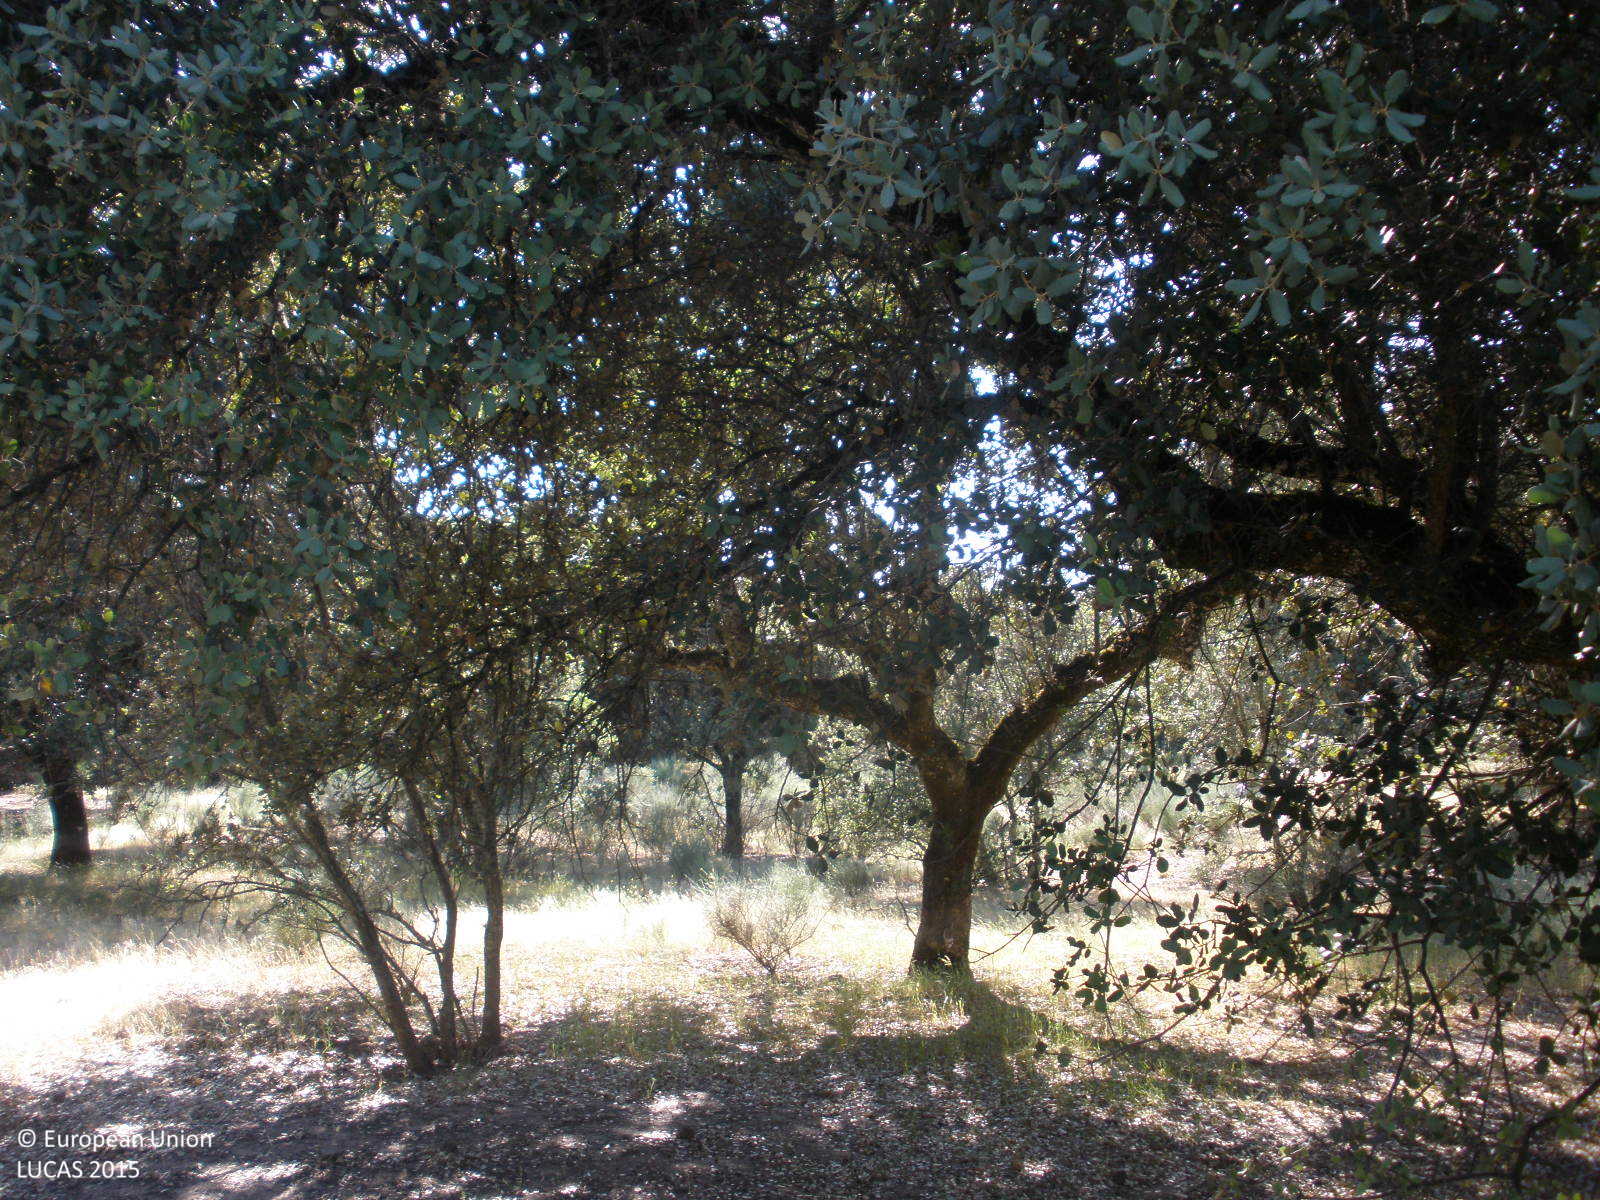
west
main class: Woodland
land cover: Broadleaved woodland
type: broadleaved evergreen forest
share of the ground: 50 - 75 %
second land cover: Grassland without tree/shrub cover
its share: > 75 %
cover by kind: broadleaved forest trees 70 %, herbaceous plants 30 %
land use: Forestry
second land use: Agriculture (excluding fallow land and kitchen gardens)
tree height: > 5 m
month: May
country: ES
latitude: 40.1340
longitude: -6.2609
